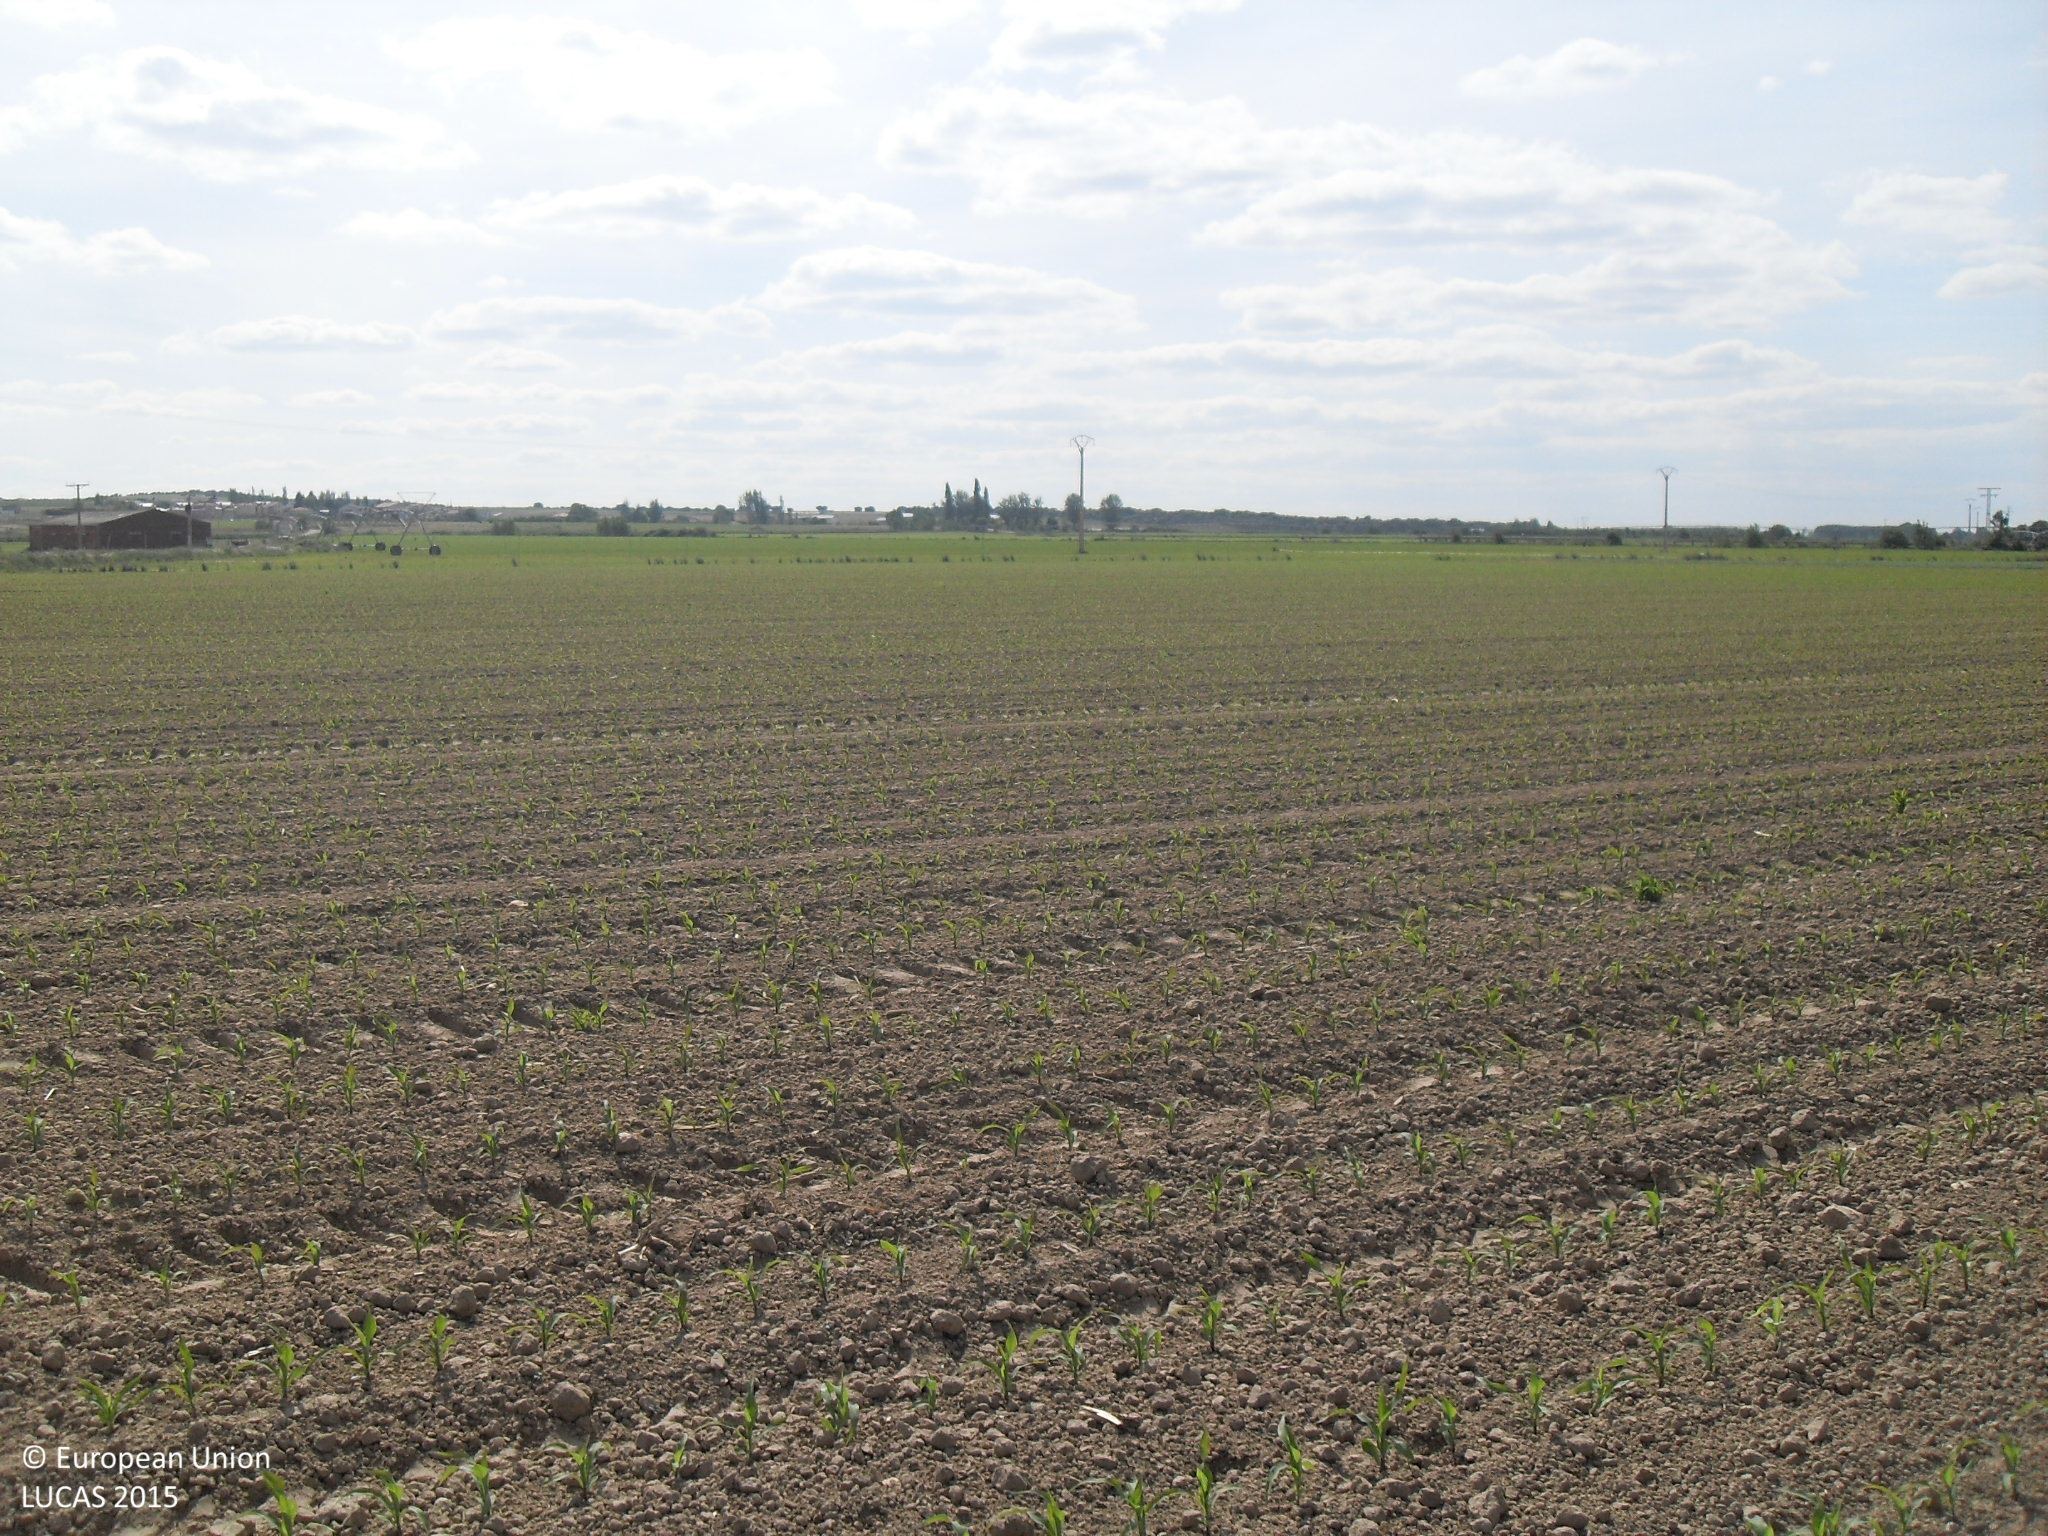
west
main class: Cropland
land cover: Maize
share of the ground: < 10 %
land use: Agriculture (excluding fallow land and kitchen gardens)
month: May
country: ES
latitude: 41.0280
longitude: -5.7435
